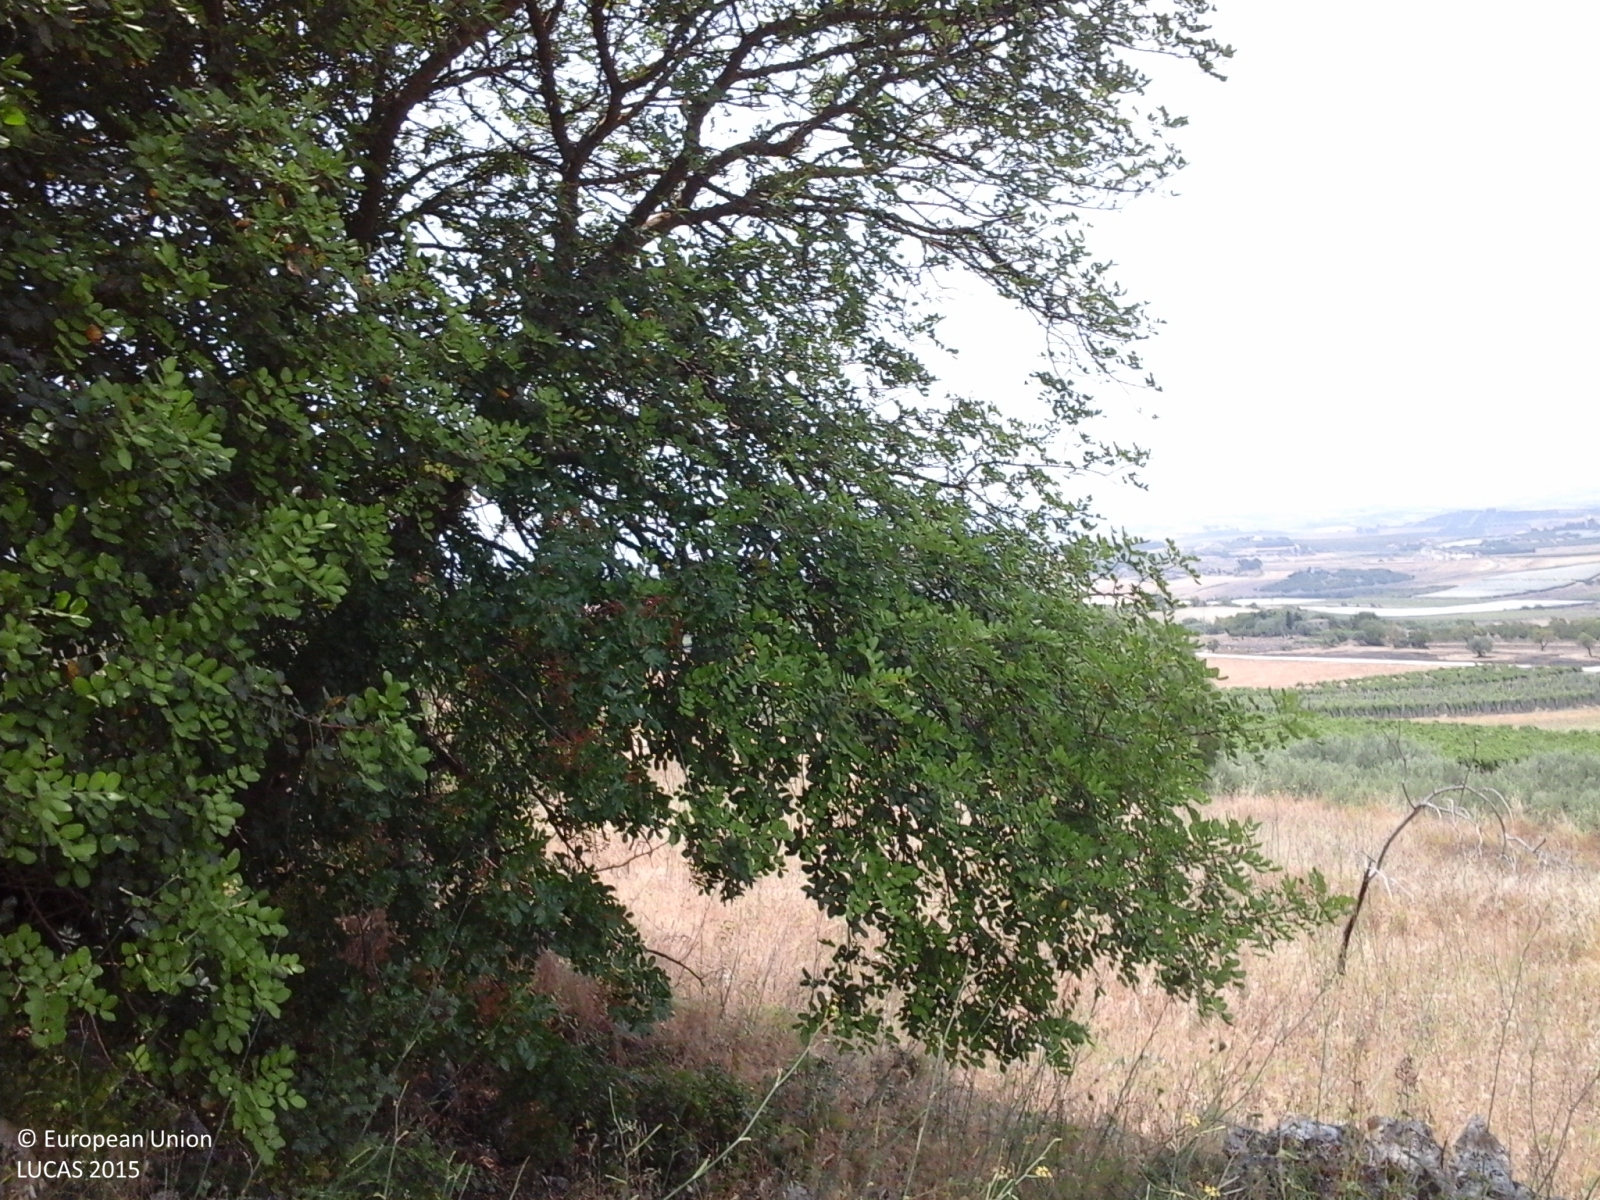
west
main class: Grassland
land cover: Grassland with sparse tree/shrub cover
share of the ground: > 75 %
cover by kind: herbaceous plants 85 %, shrubs 10 %, coniferous forest trees 5 %
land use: Semi-natural and natural areas not in use
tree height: > 5 m
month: July
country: IT
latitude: 37.2837
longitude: 13.9509
